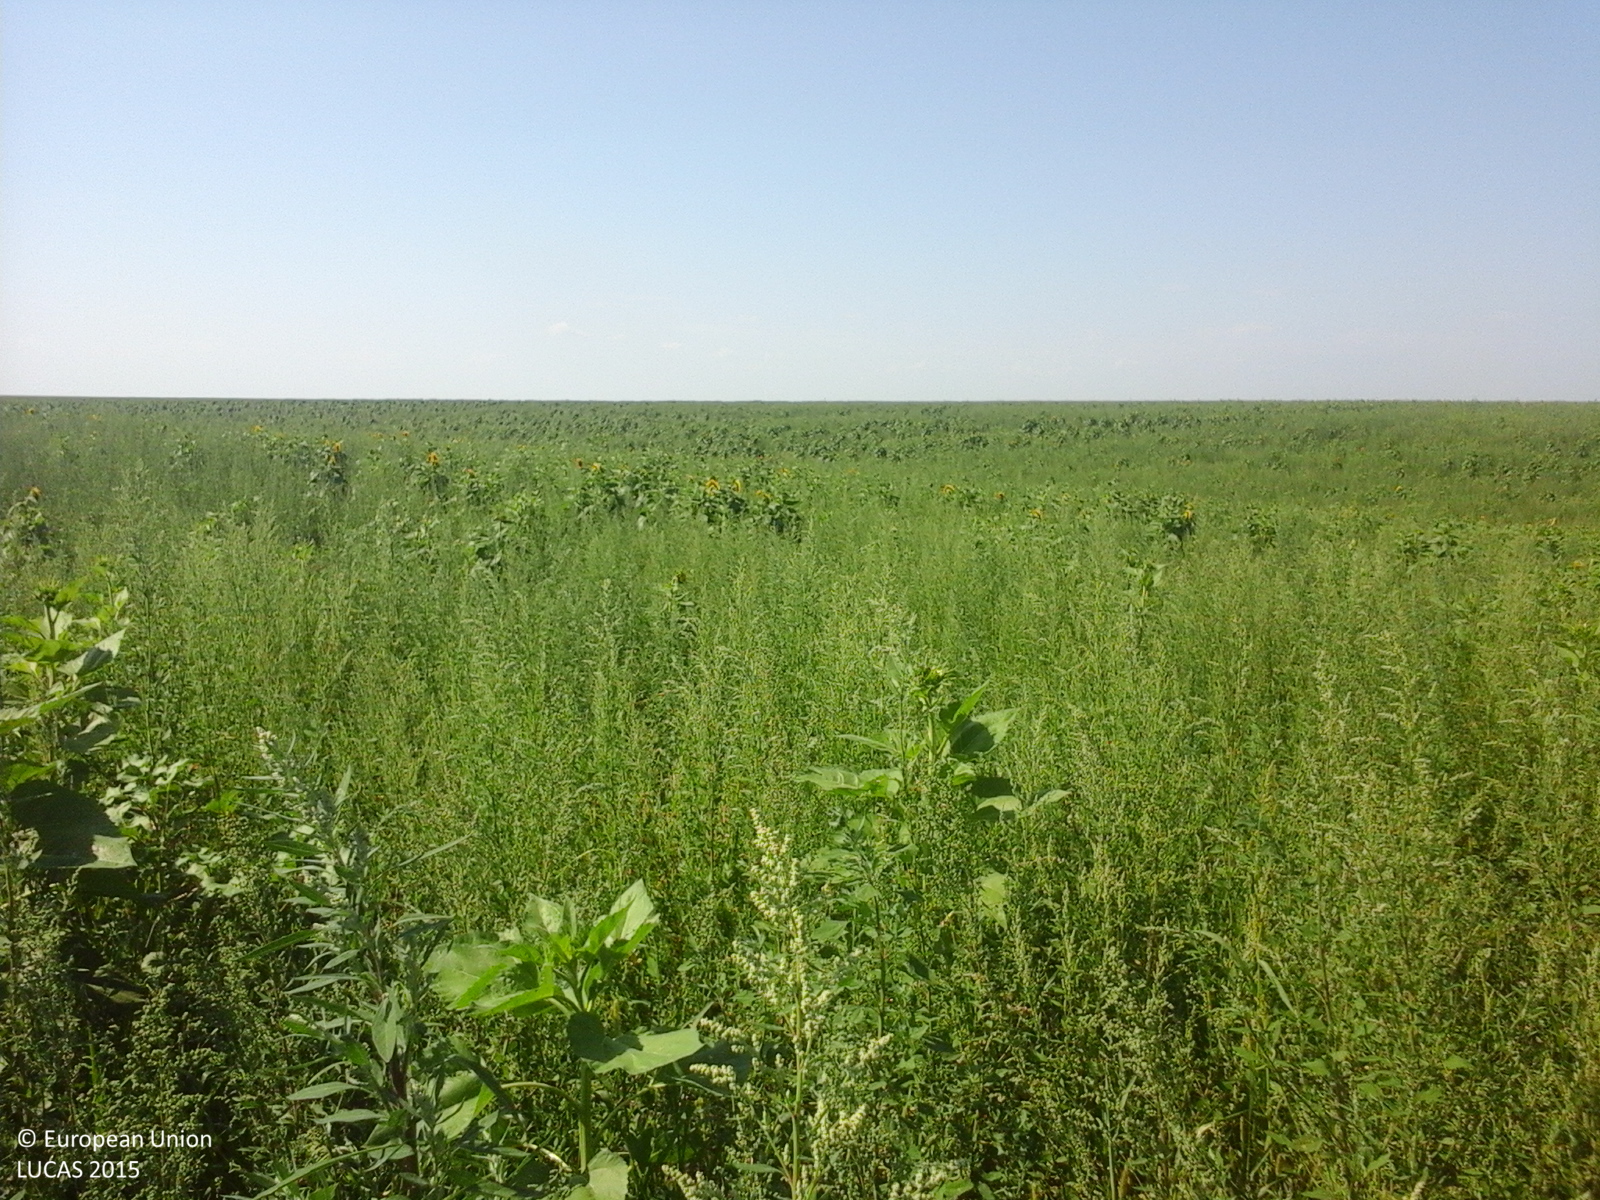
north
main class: Grassland
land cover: Spontaneously vegetated surfaces
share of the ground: > 75 %
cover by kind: herbaceous plants 100 %
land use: Fallow land
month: July
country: RO
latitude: 44.2542
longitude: 24.6630
